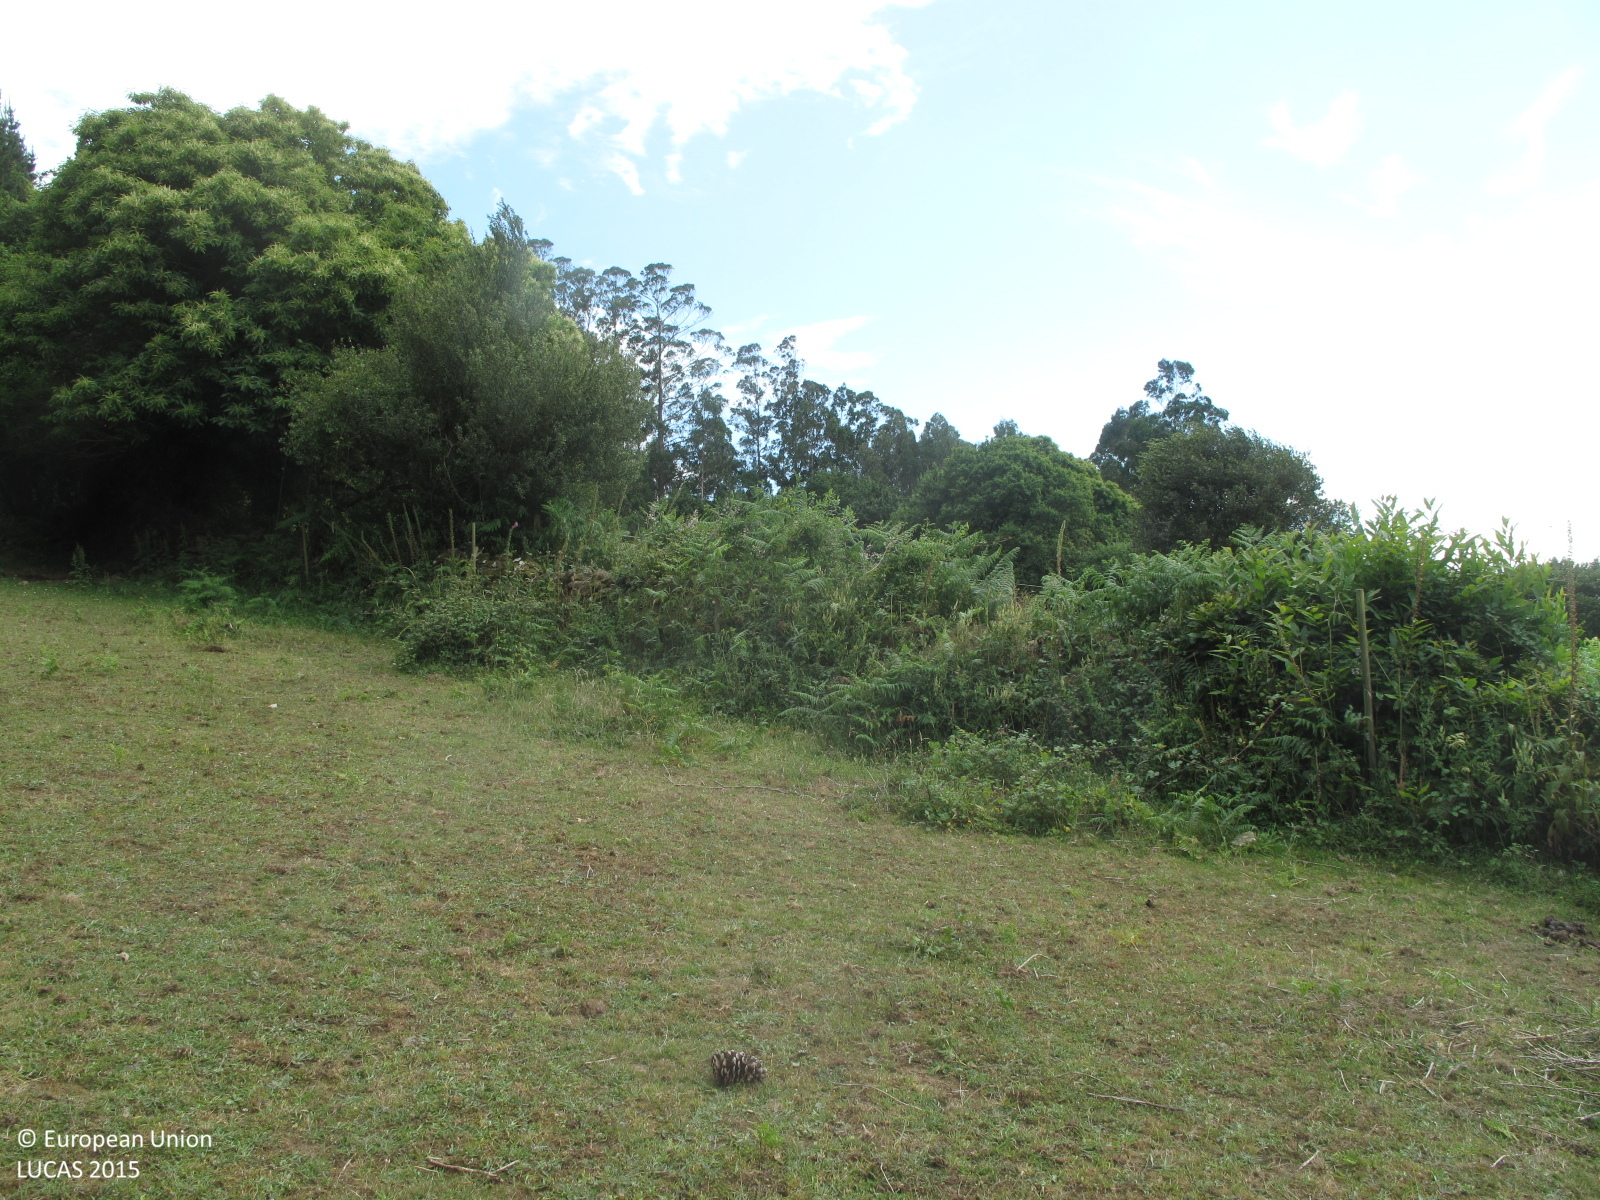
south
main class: Grassland
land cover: Grassland without tree/shrub cover
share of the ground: > 75 %
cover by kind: herbaceous plants 80 %, unconsolidated bare surface 20 %
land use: Agriculture (excluding fallow land and kitchen gardens)
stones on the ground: < 10 %
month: July
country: ES
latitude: 43.2075
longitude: -8.5851
